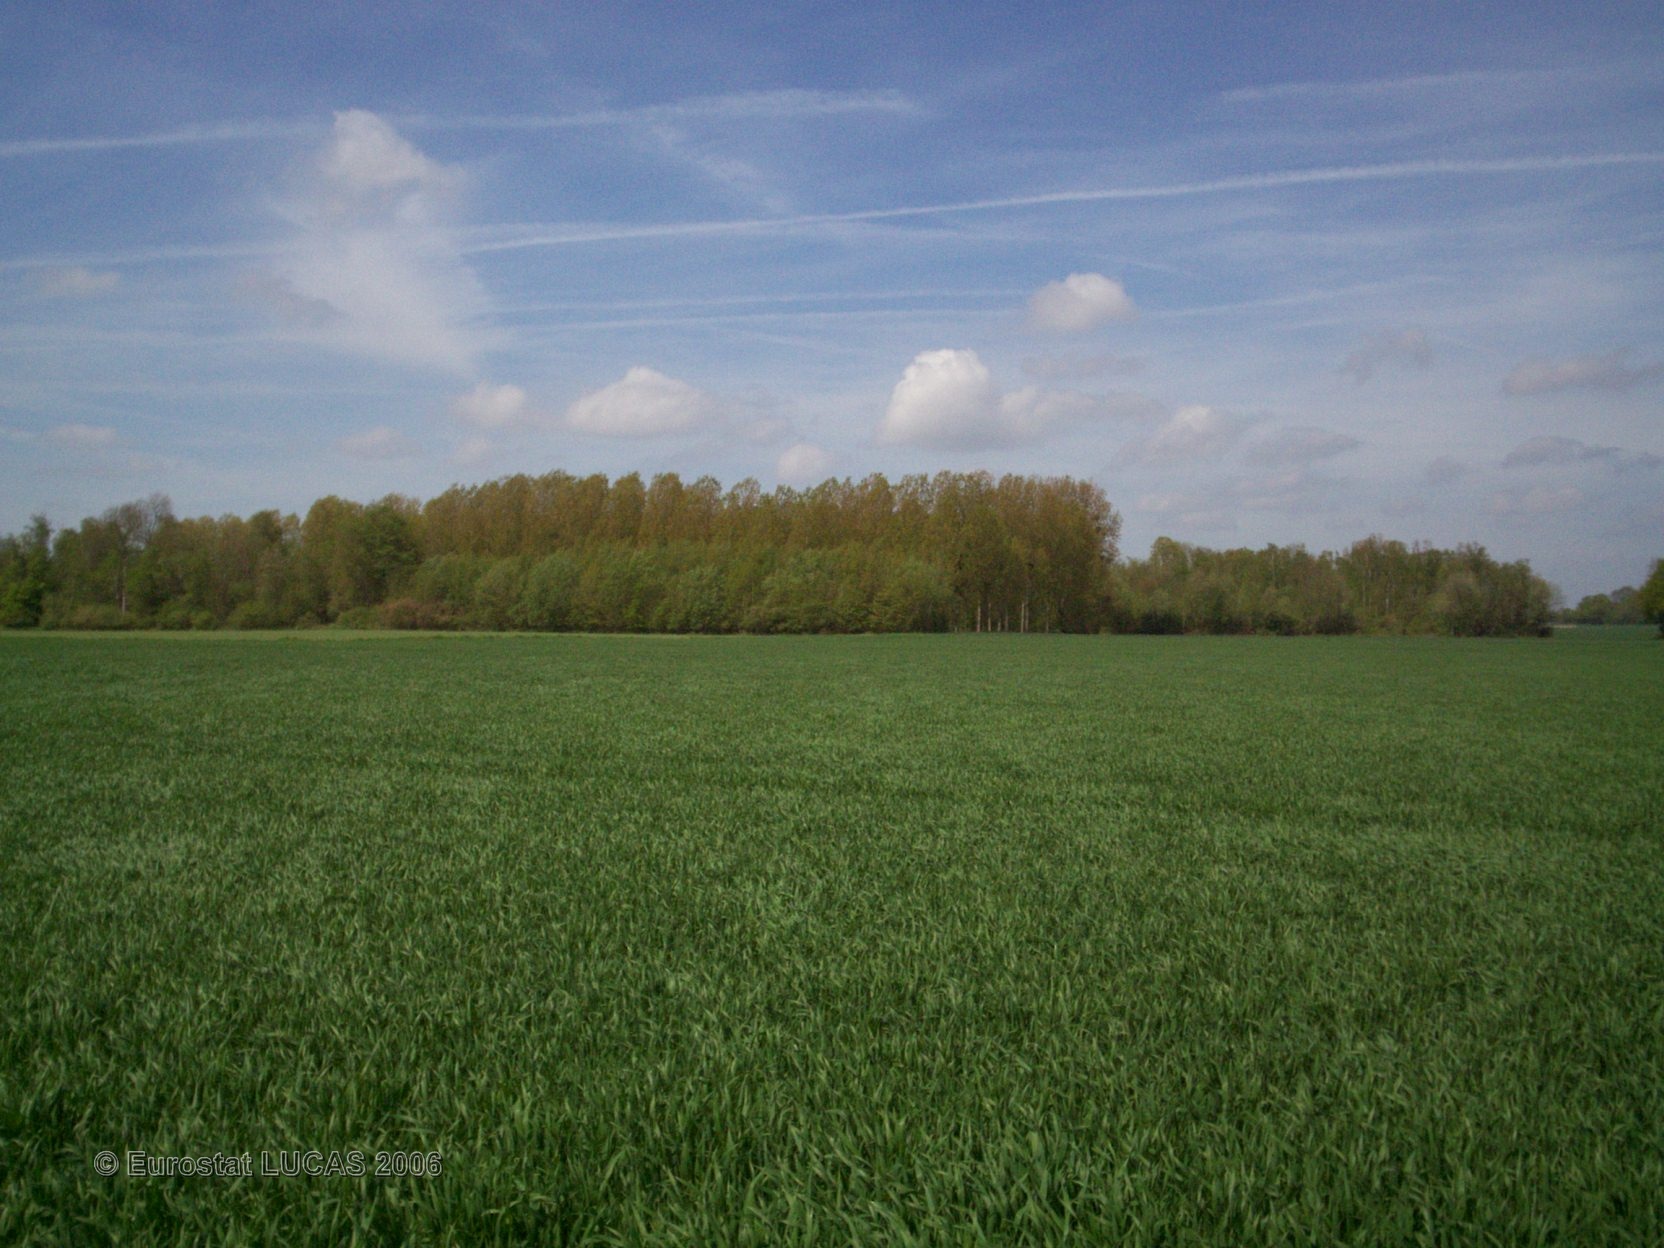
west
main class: Cropland
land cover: Common wheat
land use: Agriculture (excluding fallow land and kitchen gardens)
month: May
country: FR
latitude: 48.8411
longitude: 2.8645
